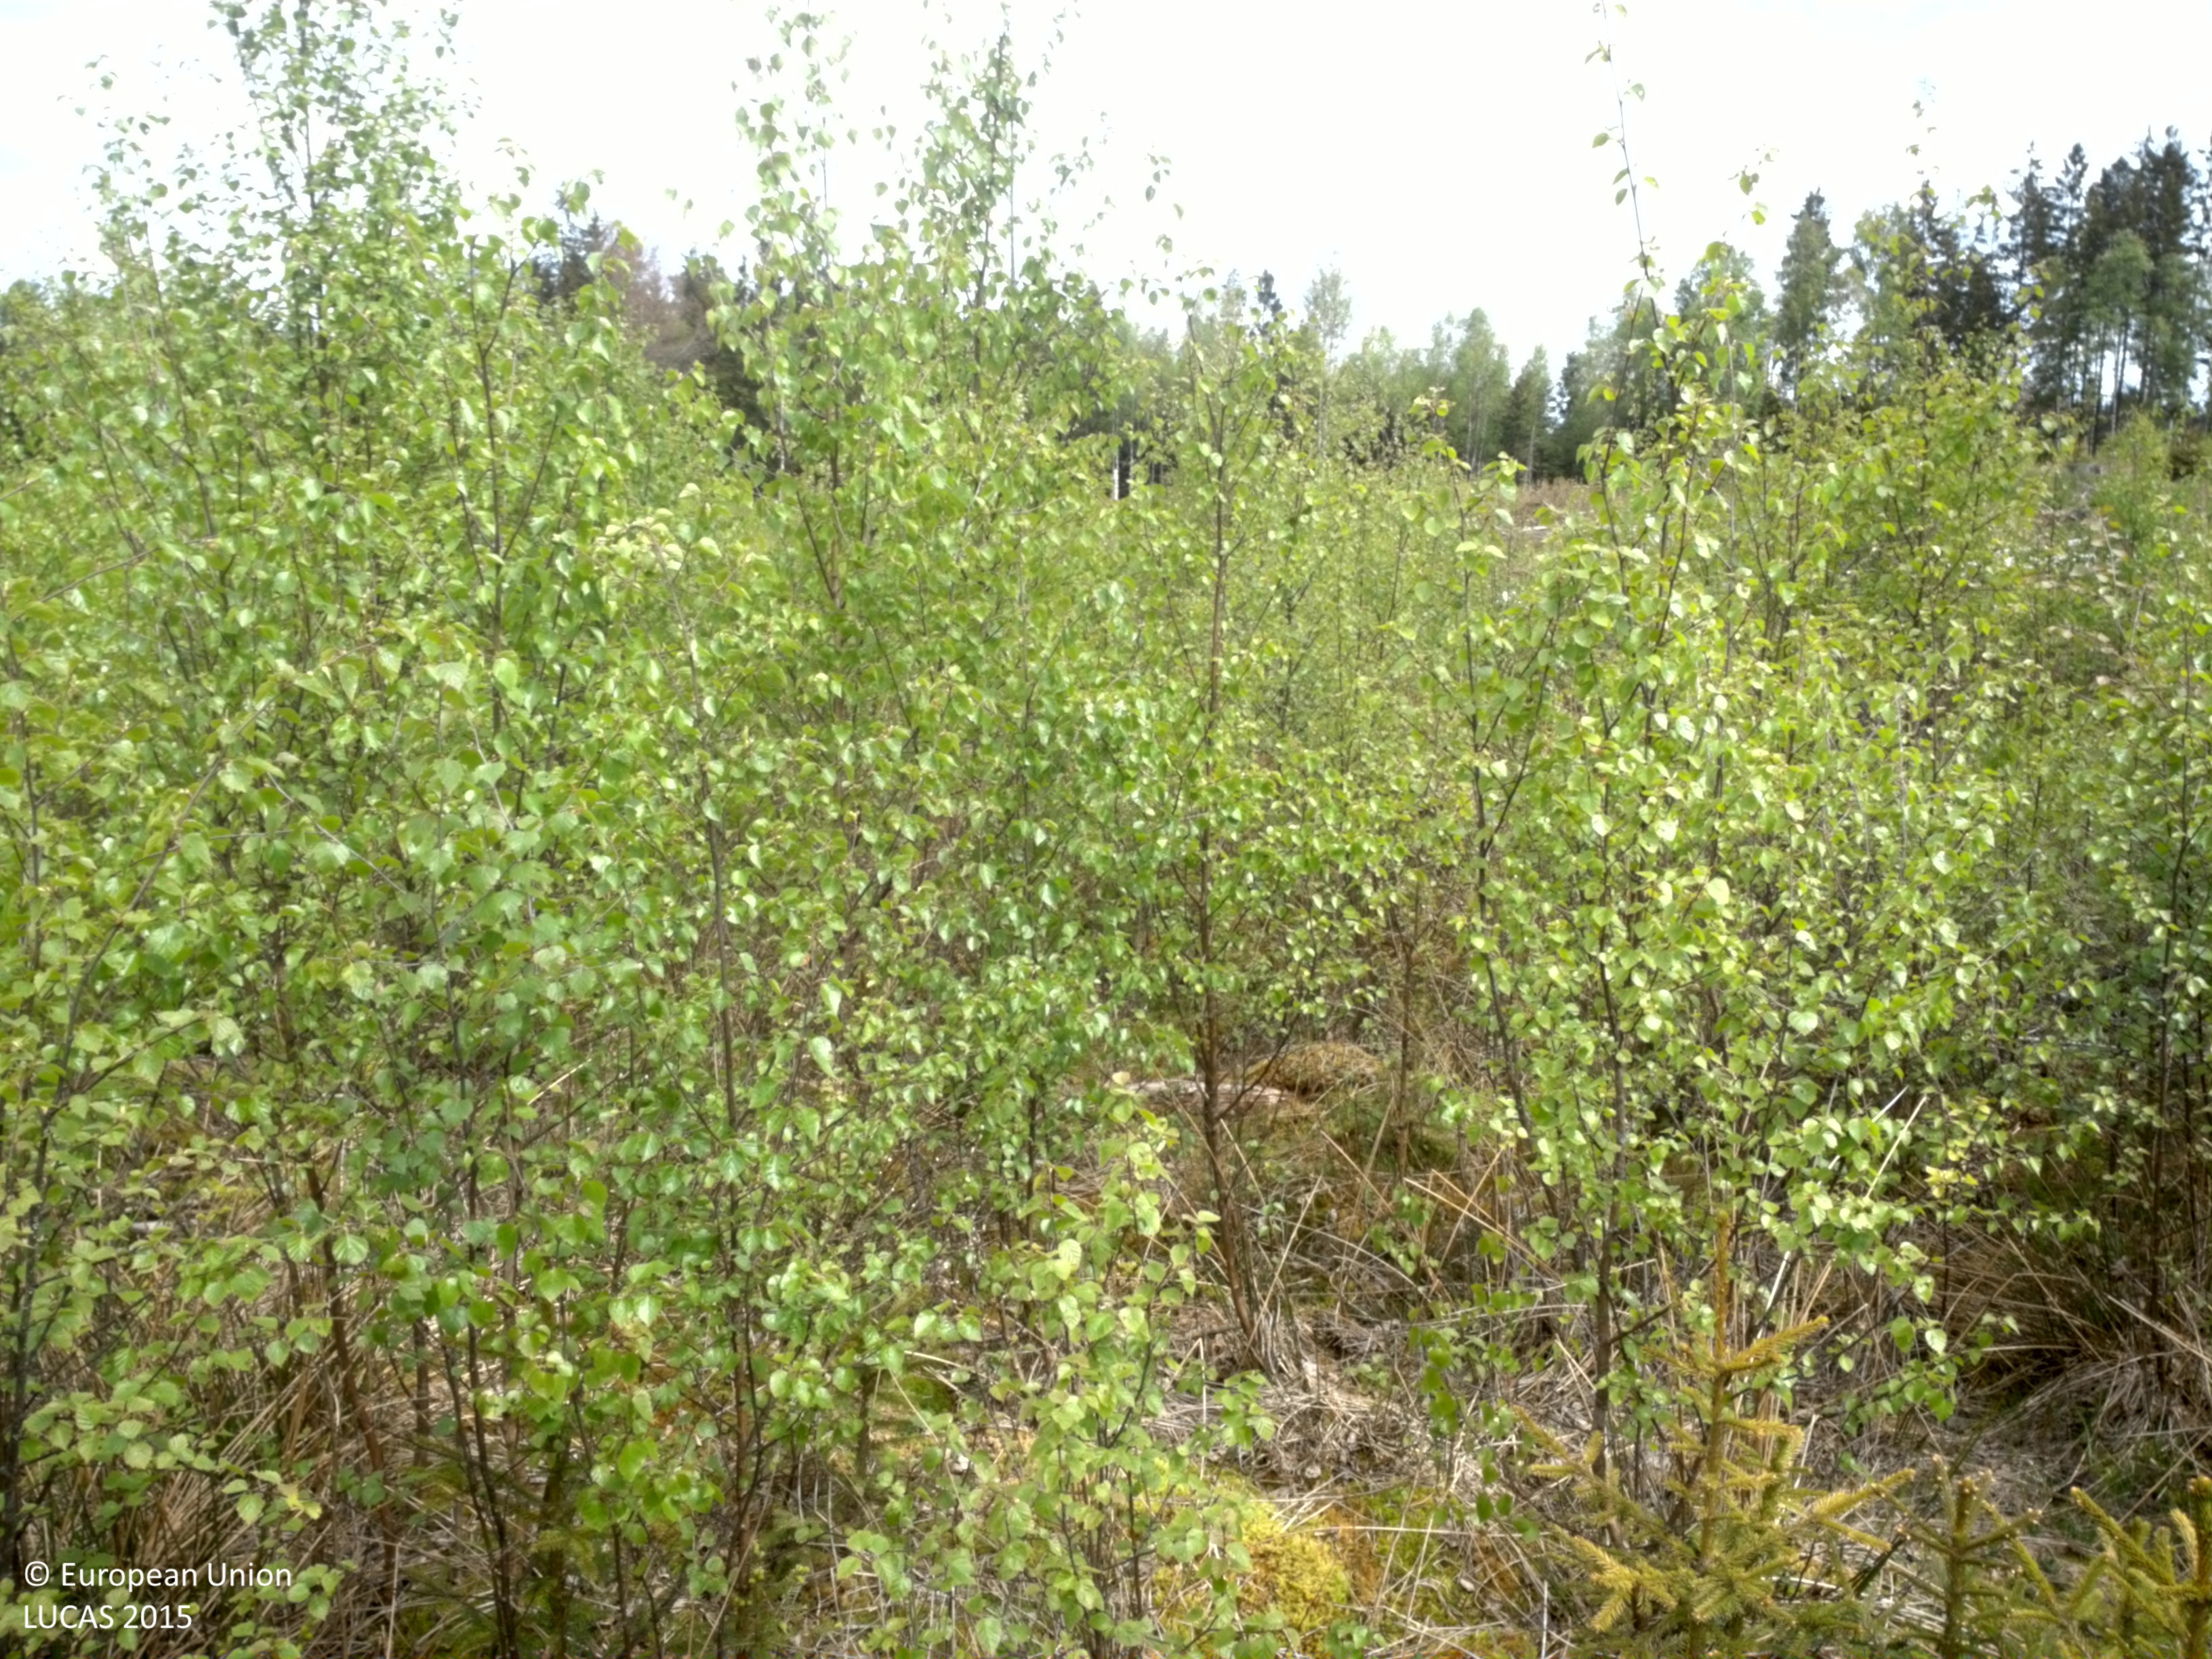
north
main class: Woodland
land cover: Broadleaved woodland
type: hemiboreal forest and nemoral coniferous forest and mixed broadleaved-coniferous forest
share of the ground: > 75 %
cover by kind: broadleaved forest trees 80 %, coniferous forest trees 10 %, shrubs 10 %
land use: Forestry
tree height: < 5 m
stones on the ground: < 10 %
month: May
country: SE
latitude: 56.5156
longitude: 15.1828
